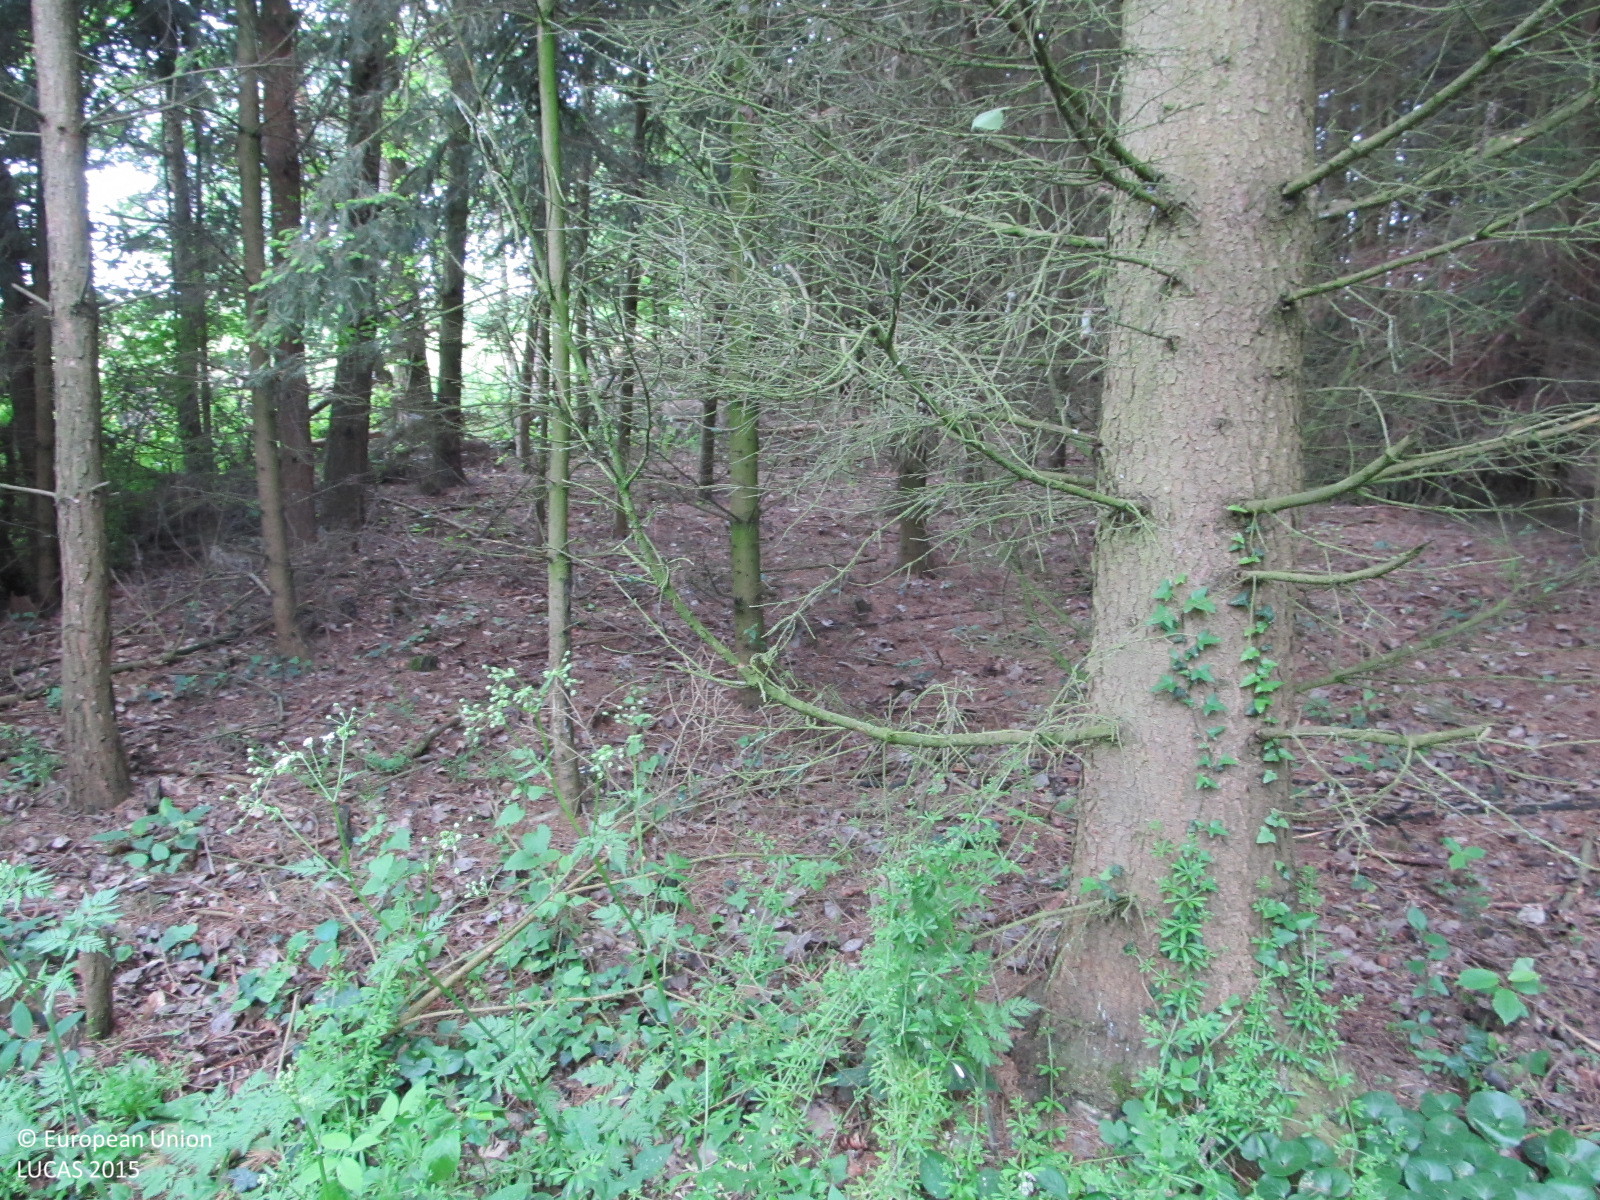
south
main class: Woodland
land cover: Spruce dominated mixed woodland
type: mesophytic deciduous forest
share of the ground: 50 - 75 %
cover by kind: coniferous forest trees 60 %, broadleaved forest trees 30 %, shrubs 10 %
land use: Forestry
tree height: > 5 m
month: May
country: AT
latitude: 48.6633
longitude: 15.5018
